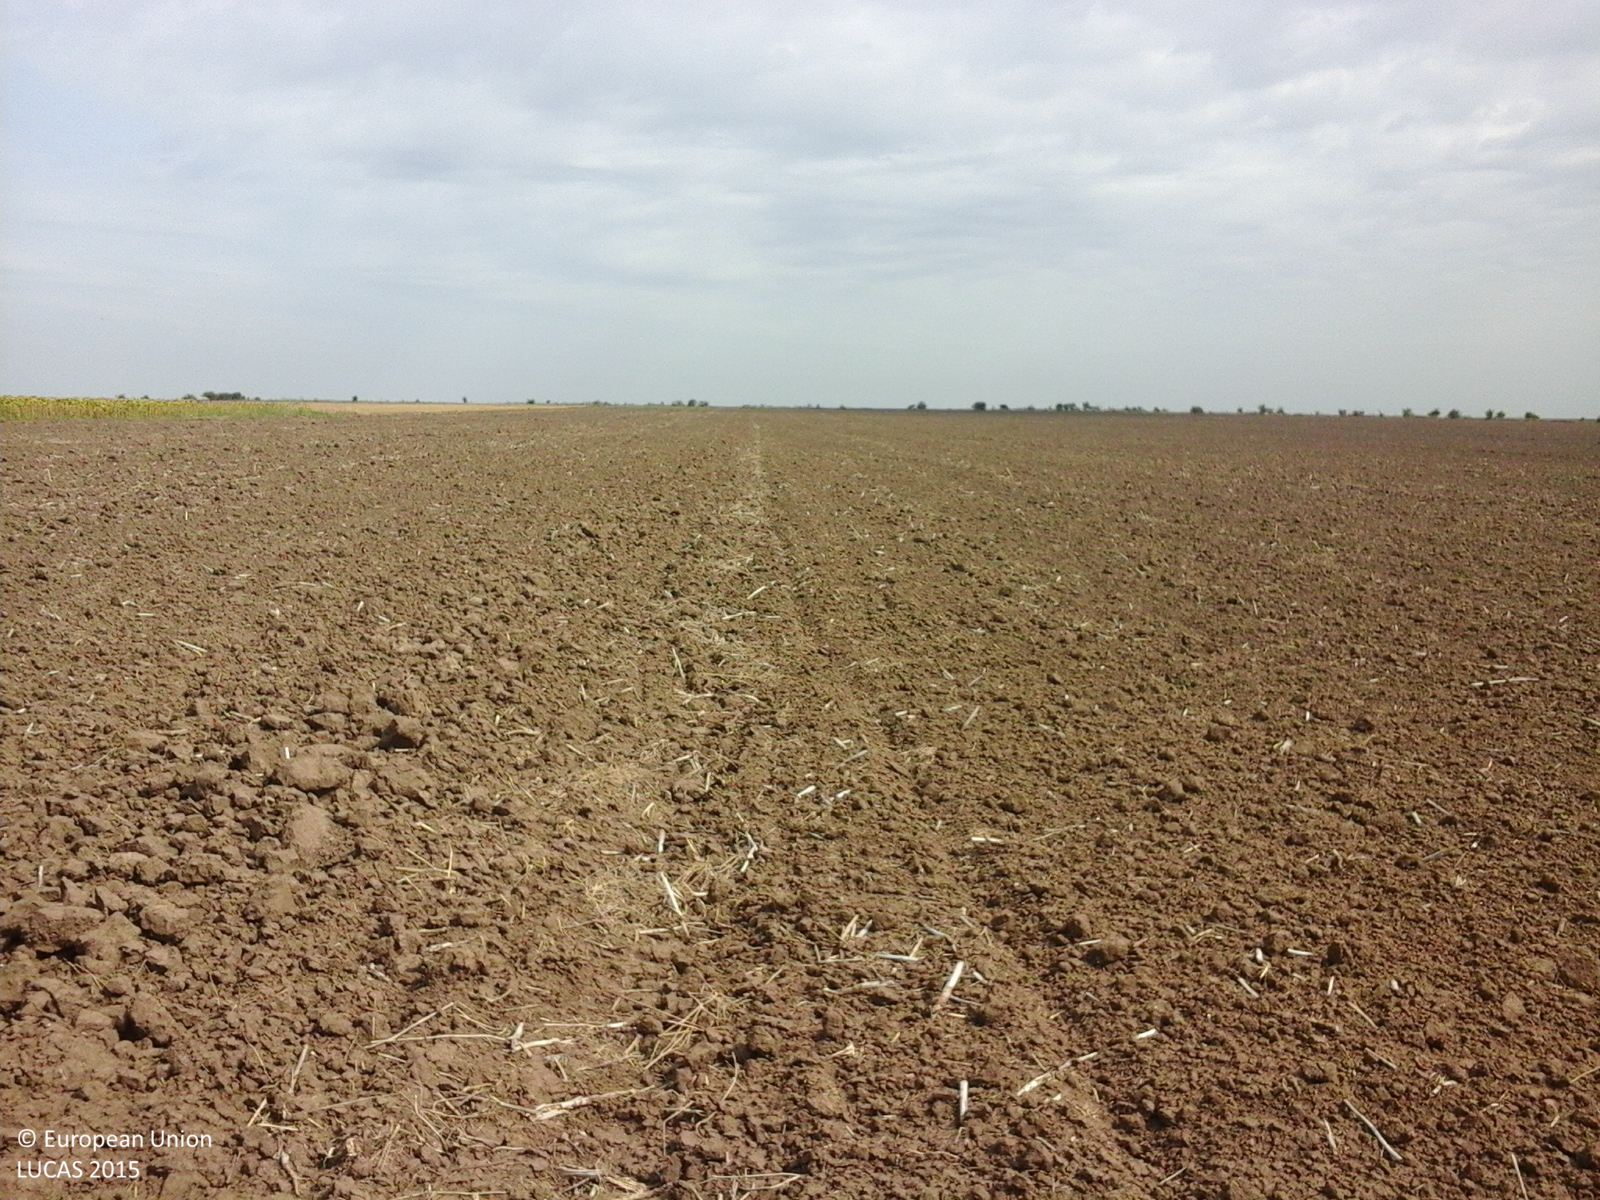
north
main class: Cropland
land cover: Rape and turnip rape
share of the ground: < 10 %
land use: Agriculture (excluding fallow land and kitchen gardens)
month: August
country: RO
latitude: 43.7965
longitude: 28.3941
